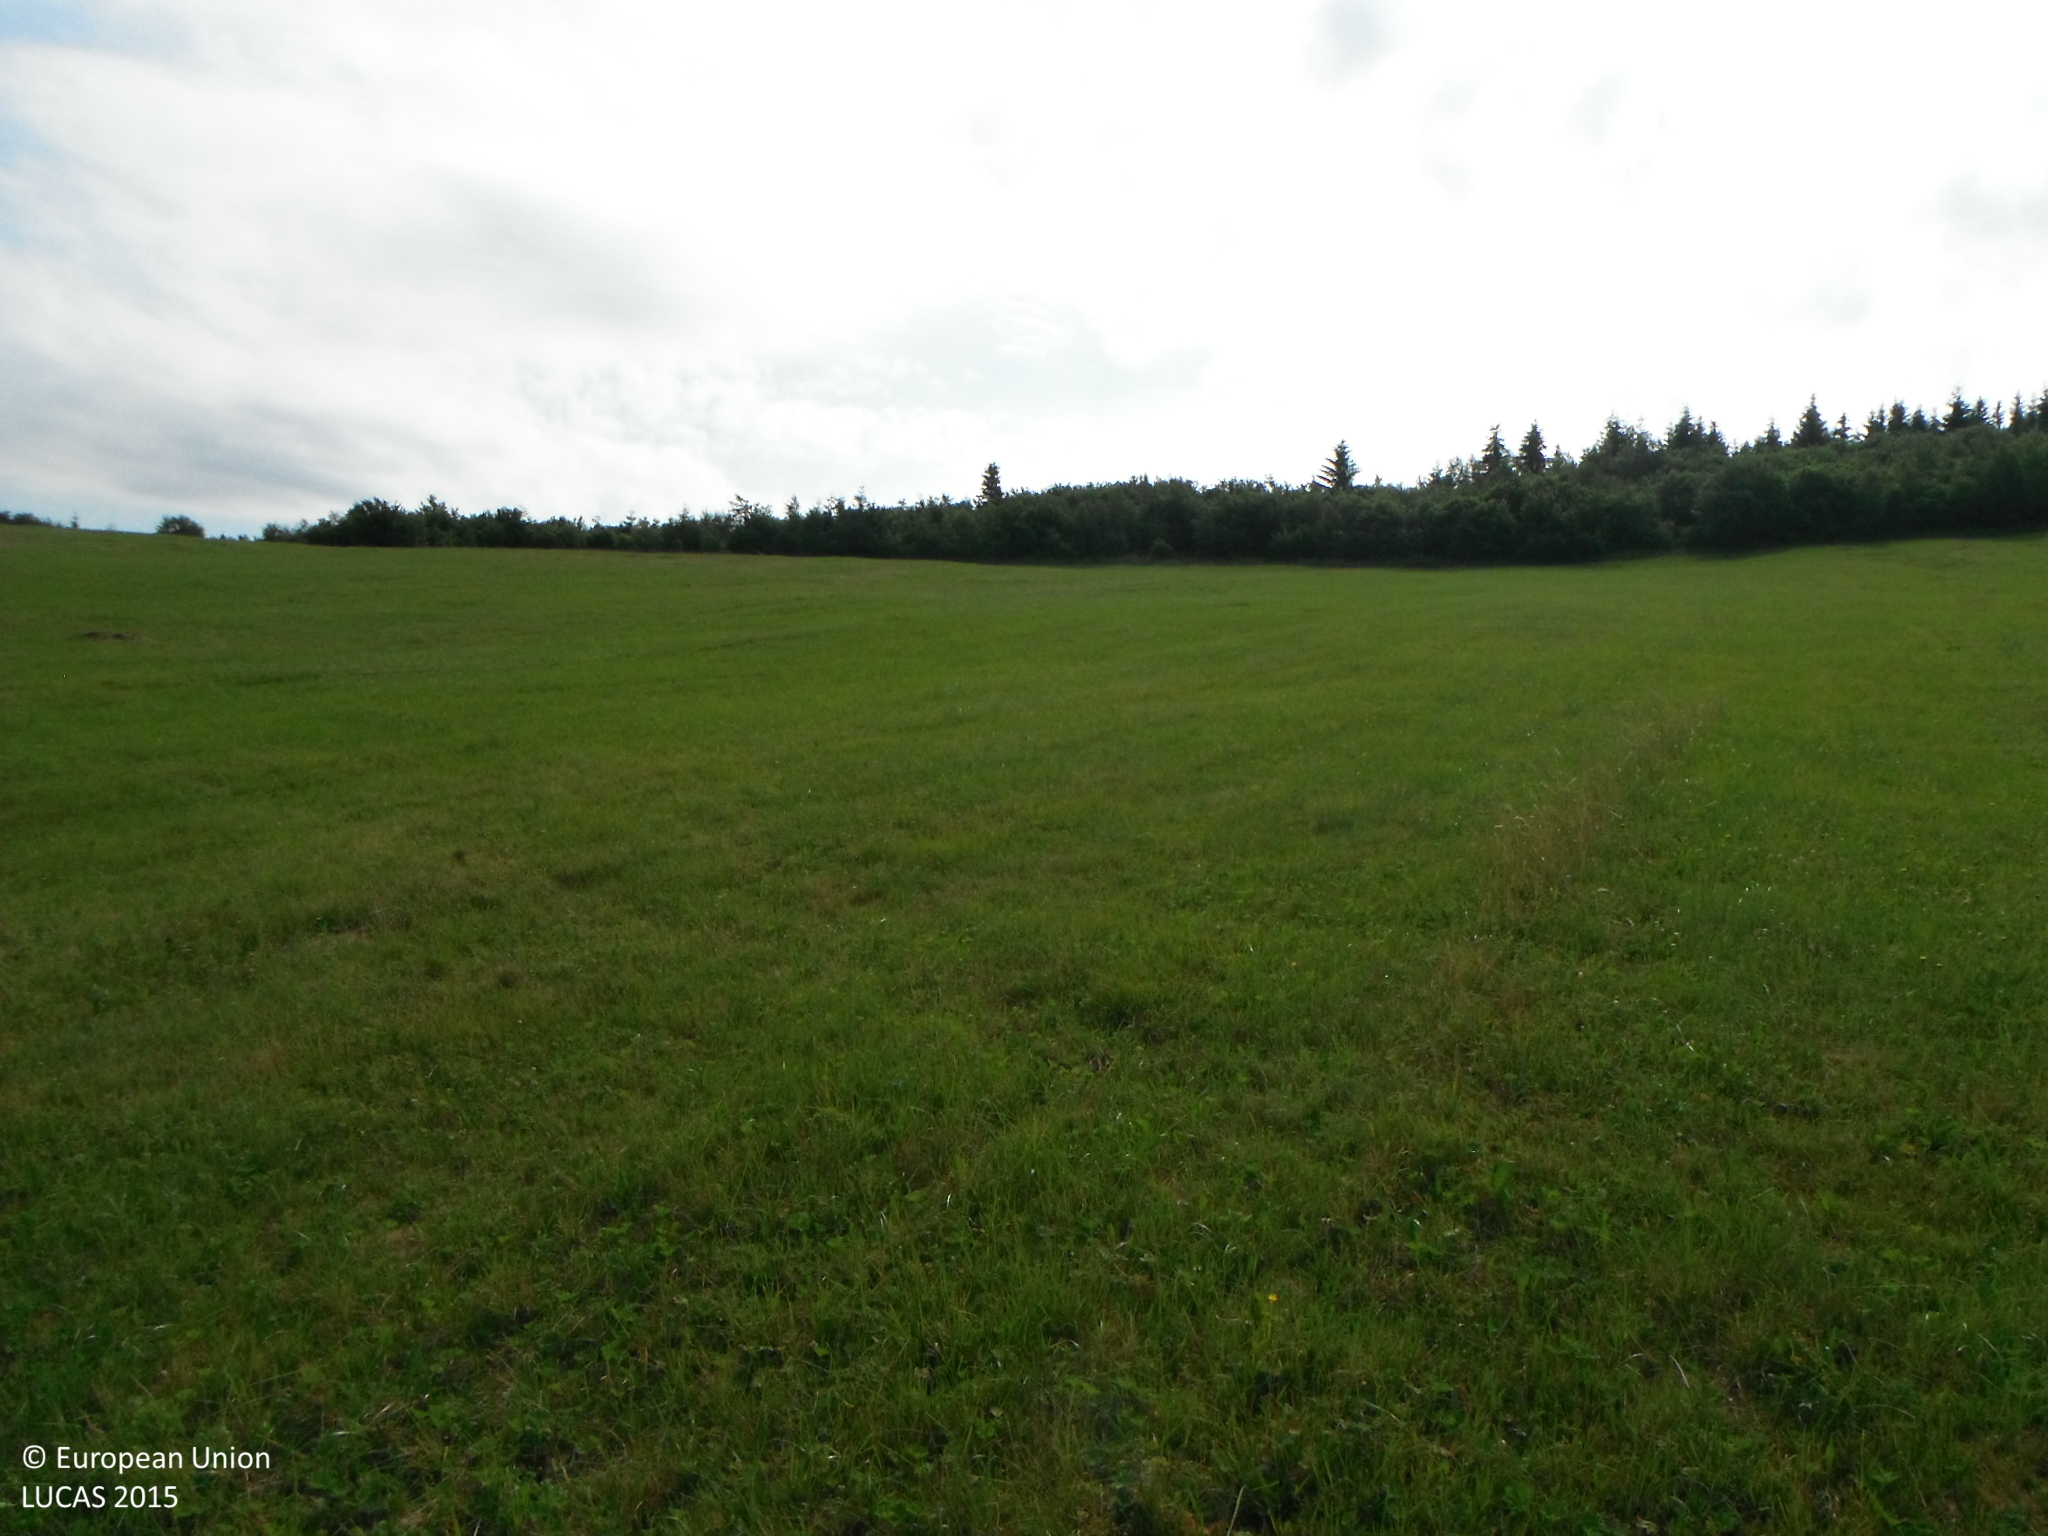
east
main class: Grassland
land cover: Grassland without tree/shrub cover
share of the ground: > 75 %
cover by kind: herbaceous plants 100 %
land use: Agriculture (excluding fallow land and kitchen gardens)
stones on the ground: < 10 %
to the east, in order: Grassland without tree/shrub cover; Broadleaved woodland; Grassland without tree/shrub cover
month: July
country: SK
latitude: 49.3092
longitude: 19.3644
